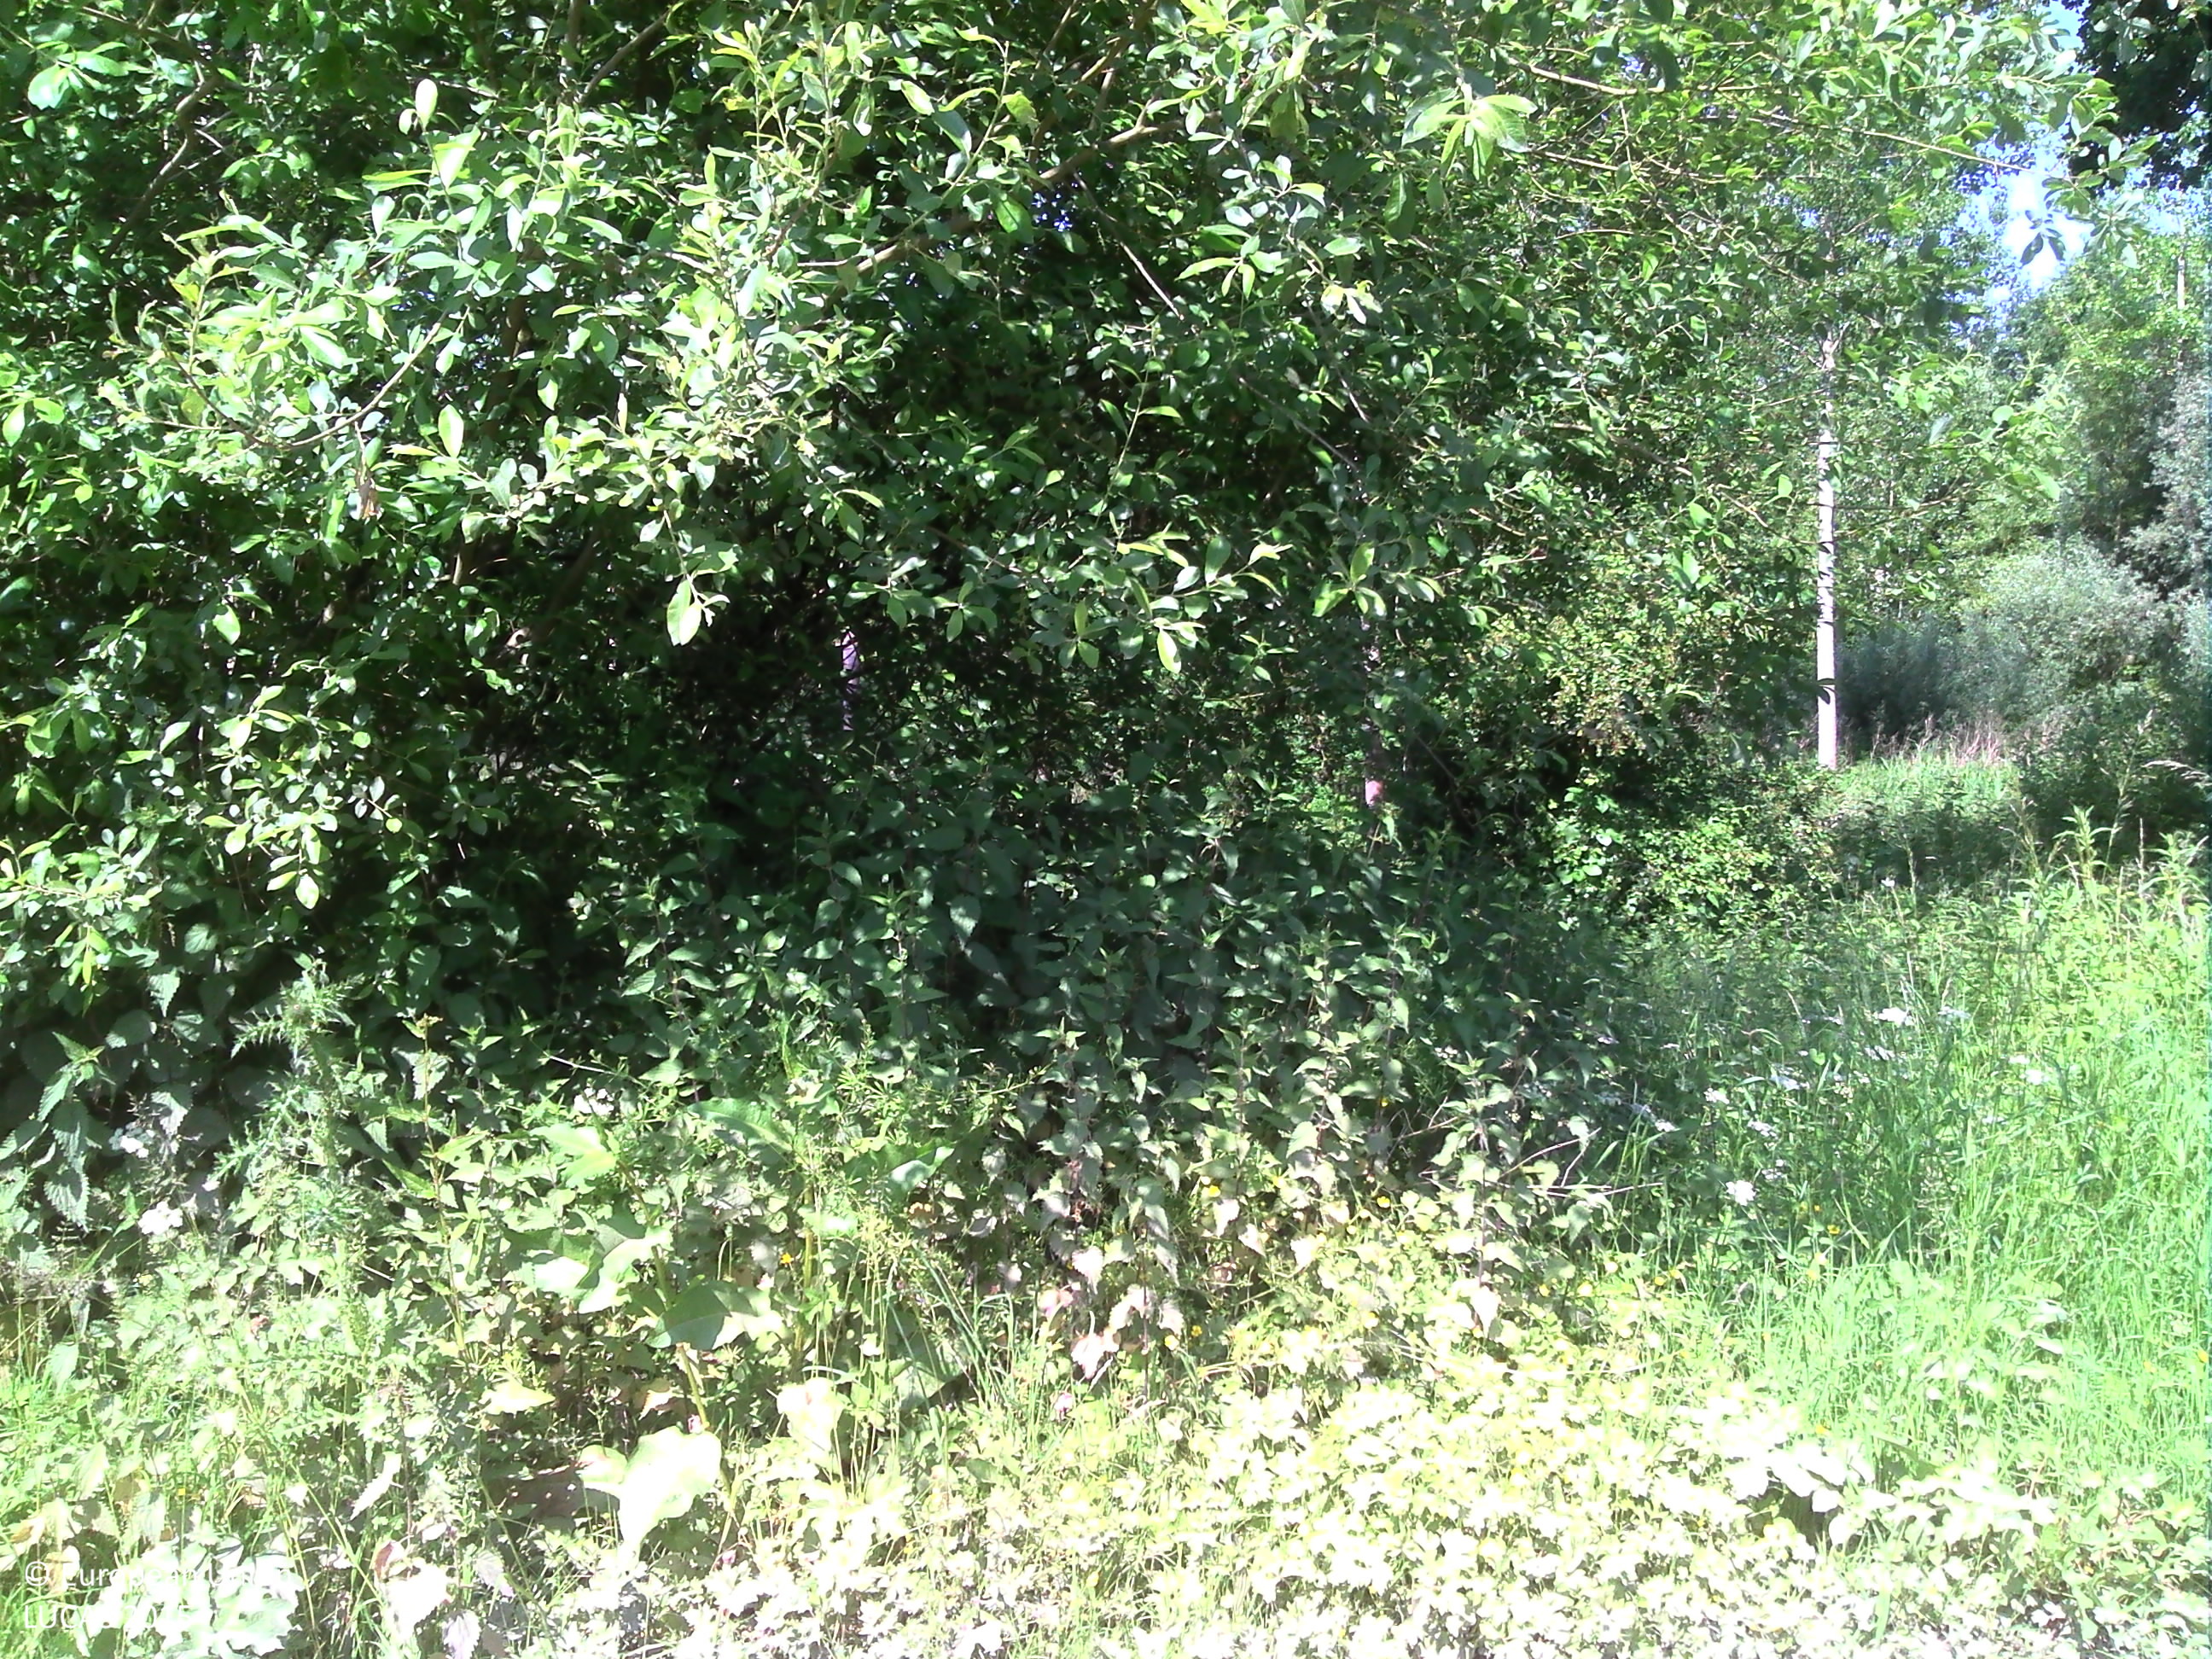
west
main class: Grassland
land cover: Spontaneously vegetated surfaces
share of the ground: > 75 %
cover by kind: herbaceous plants 100 %
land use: Semi-natural and natural areas not in use
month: June
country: BE
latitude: 50.8158
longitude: 5.4988
